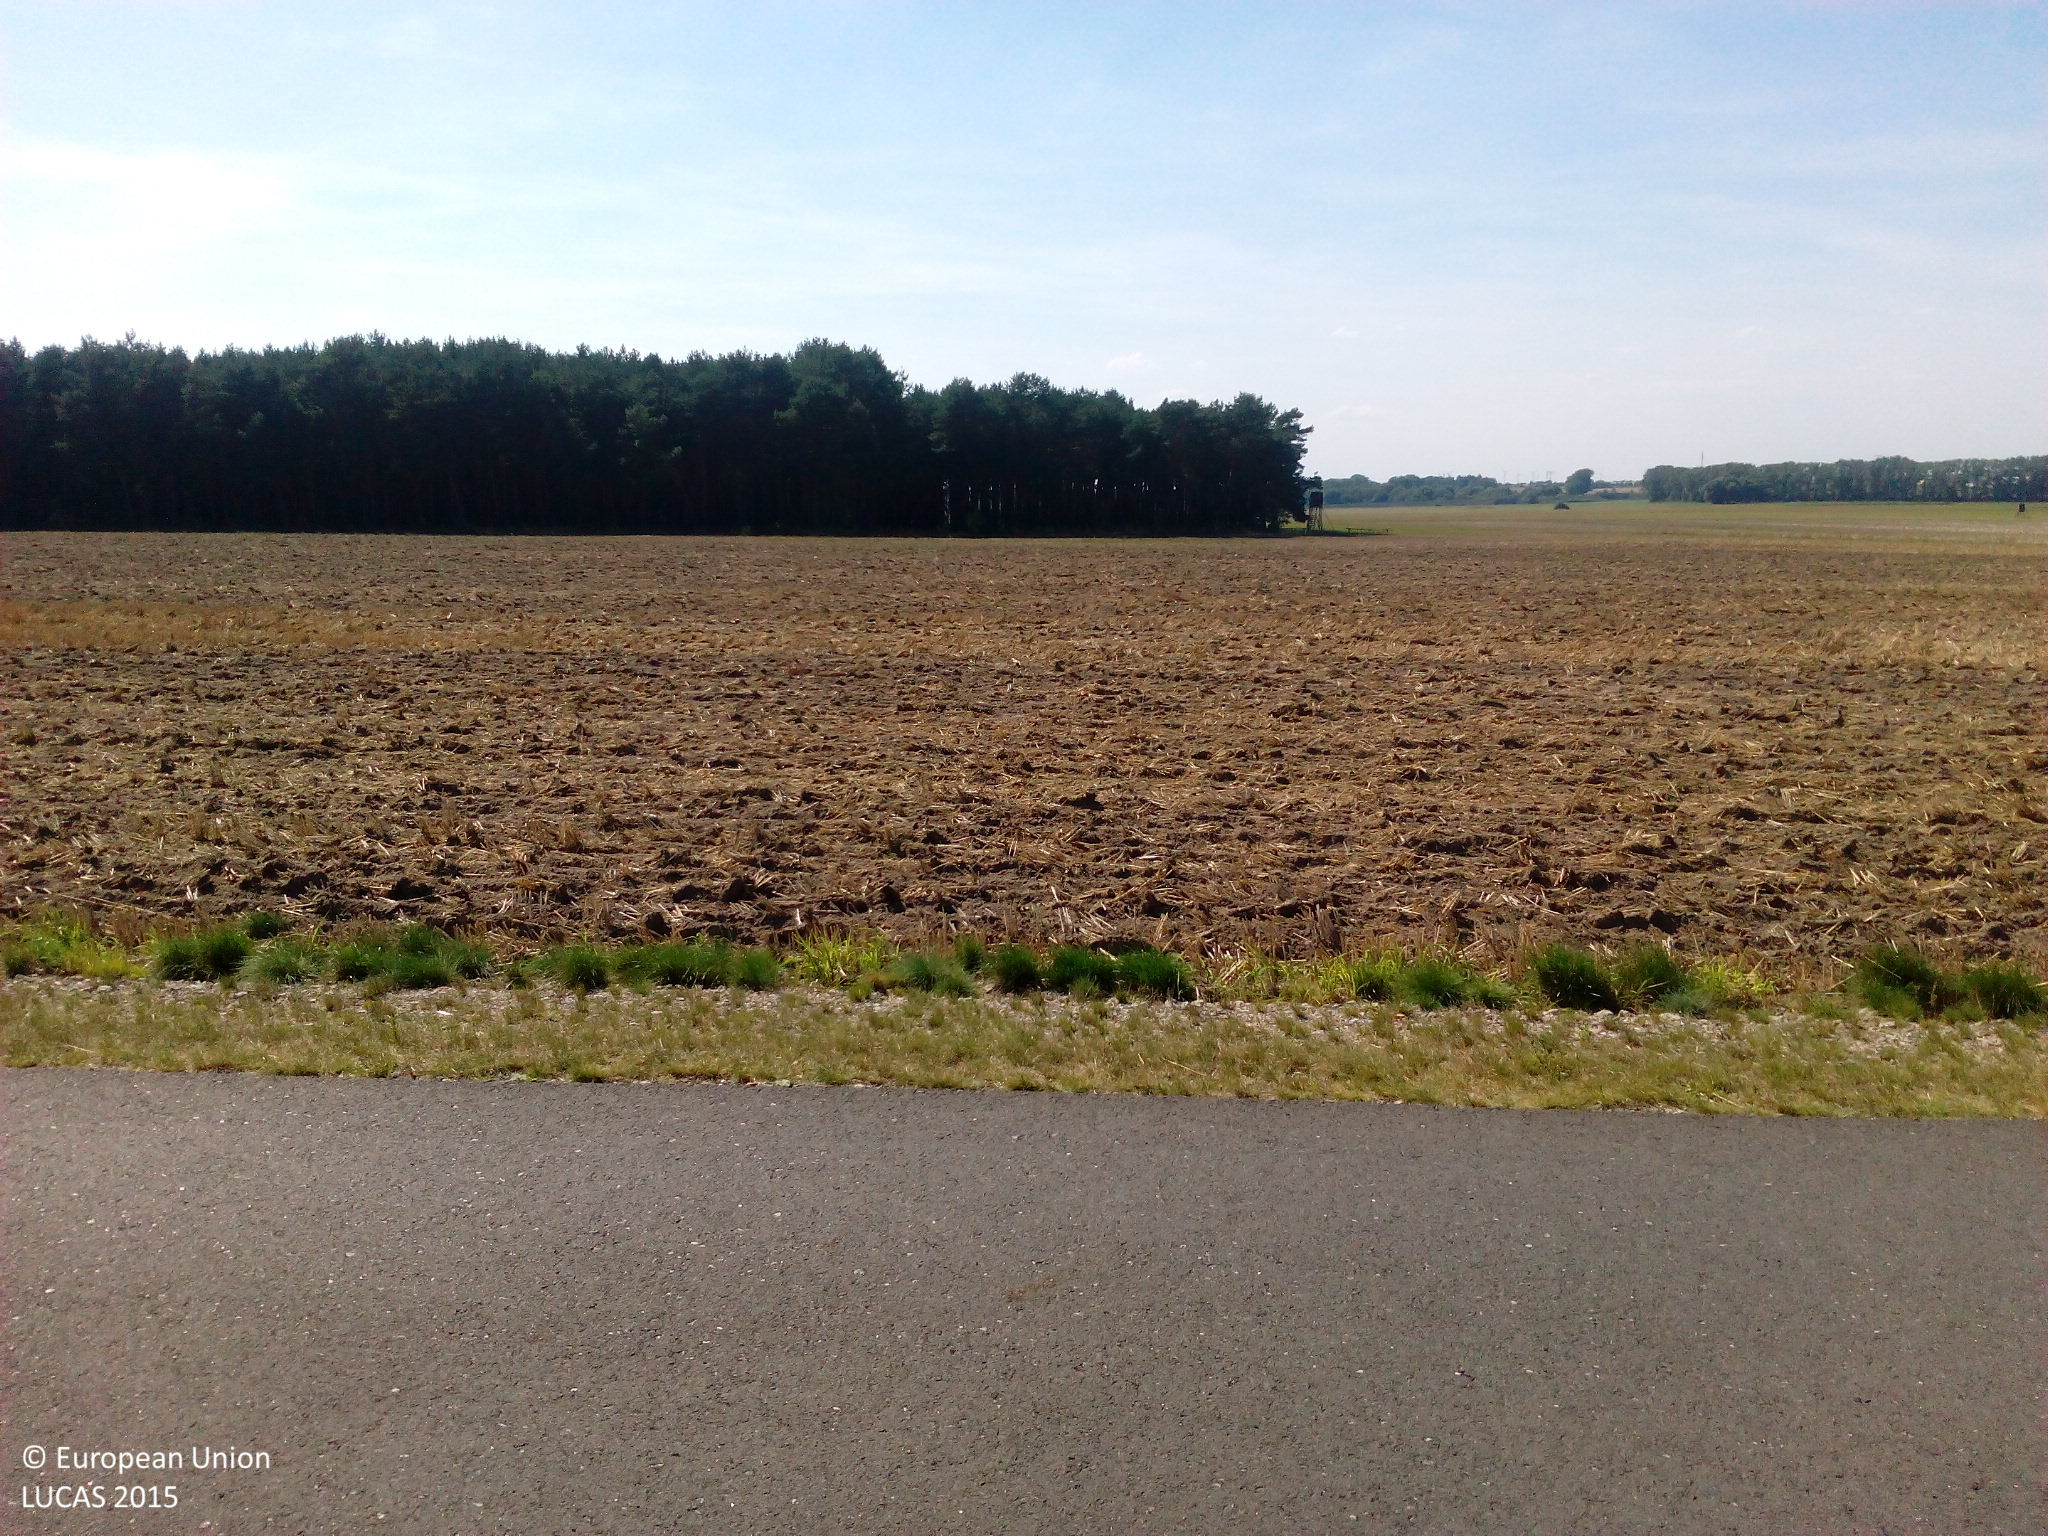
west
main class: Cropland
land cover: Maize
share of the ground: > 75 %
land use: Agriculture (excluding fallow land and kitchen gardens)
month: August
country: DE
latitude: 51.9944
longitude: 13.1313
